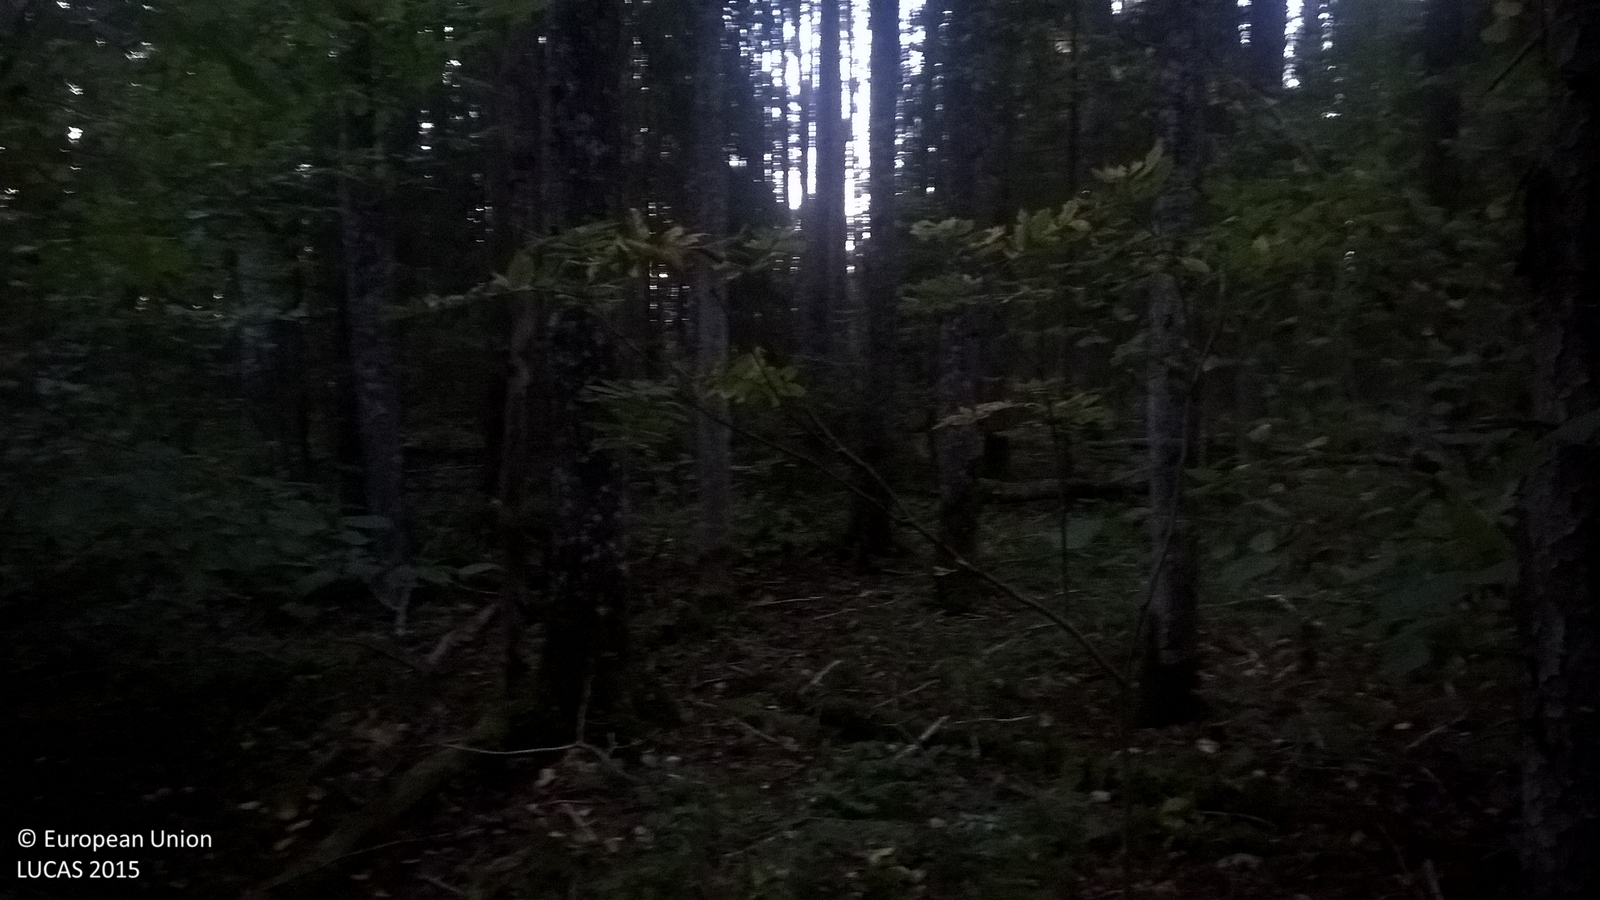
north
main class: Woodland
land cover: Other mixed woodland
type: hemiboreal forest and nemoral coniferous forest and mixed broadleaved-coniferous forest
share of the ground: > 75 %
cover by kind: broadleaved forest trees 45 %, coniferous forest trees 40 %, lichens and mosses 10 %, herbaceous plants 5 %
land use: Forestry
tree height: > 5 m
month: September
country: LV
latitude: 57.6065
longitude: 25.4947
